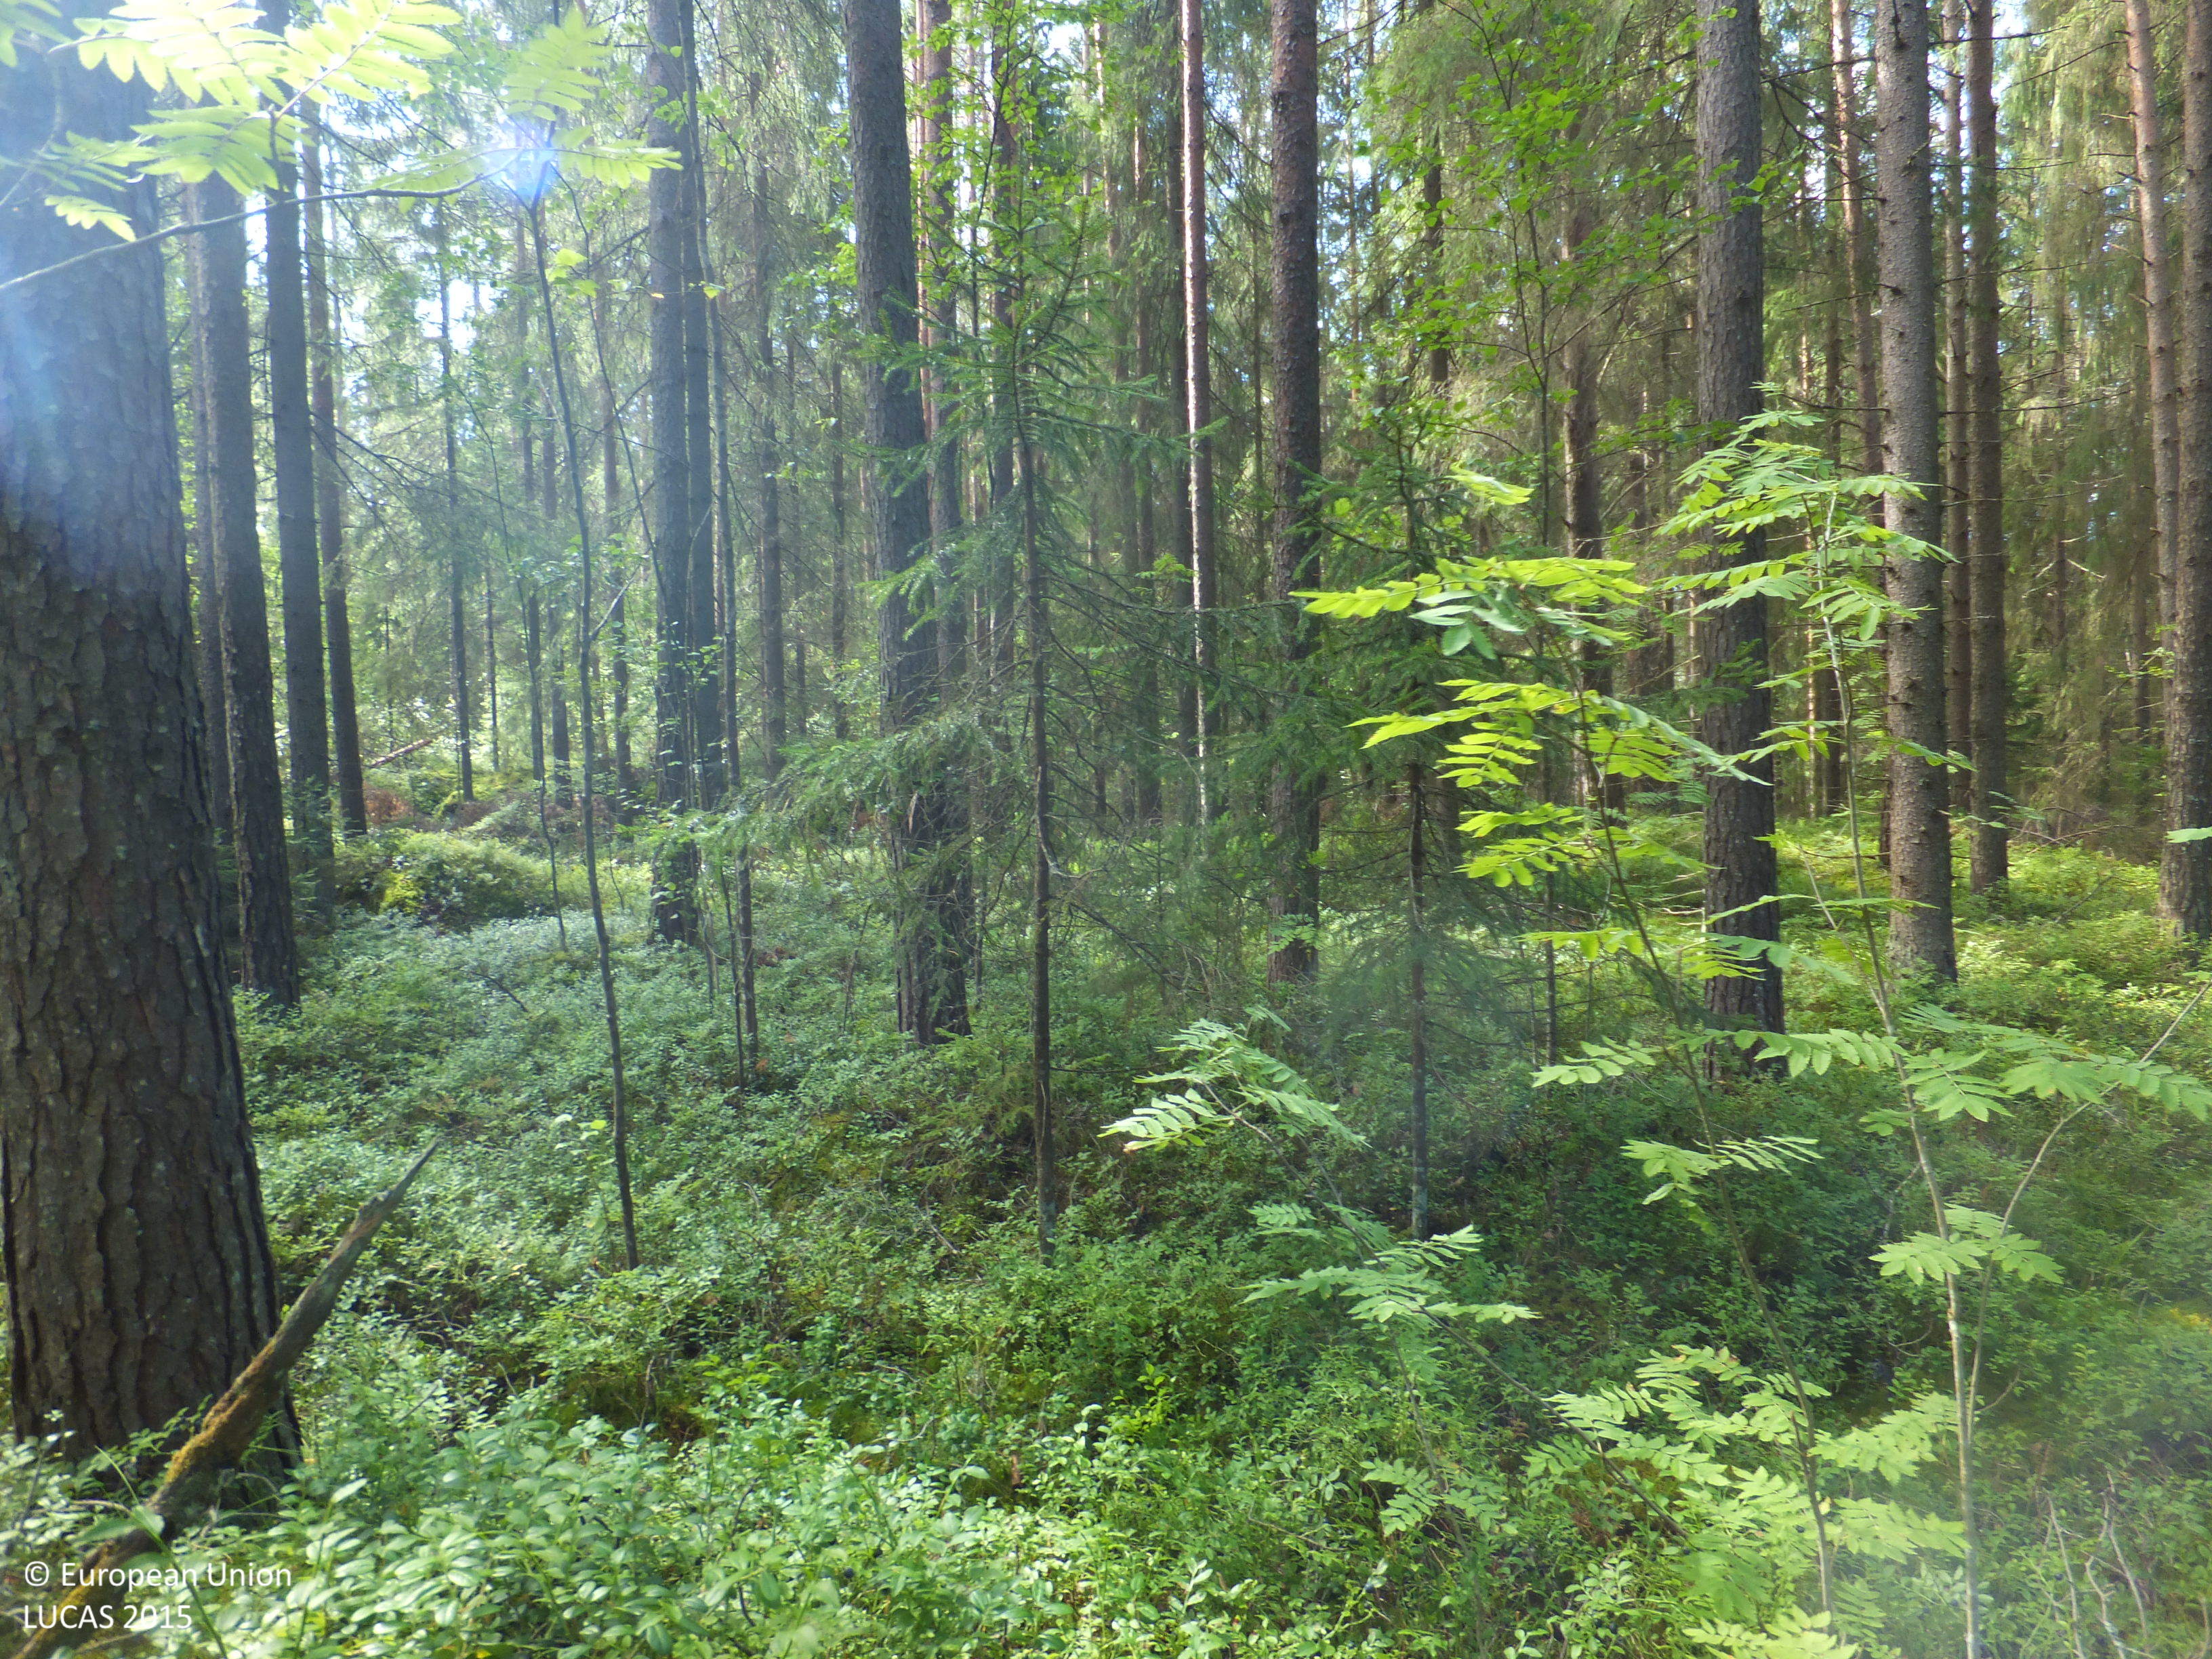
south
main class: Woodland
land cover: Other coniferous woodland
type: boreal forest
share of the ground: > 75 %
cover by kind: coniferous forest trees 75 %, shrubs 10 %, lichens and mosses 10 %, broadleaved forest trees 5 %
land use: Forestry
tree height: > 5 m
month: August
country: FI
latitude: 63.2292
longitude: 23.0924
